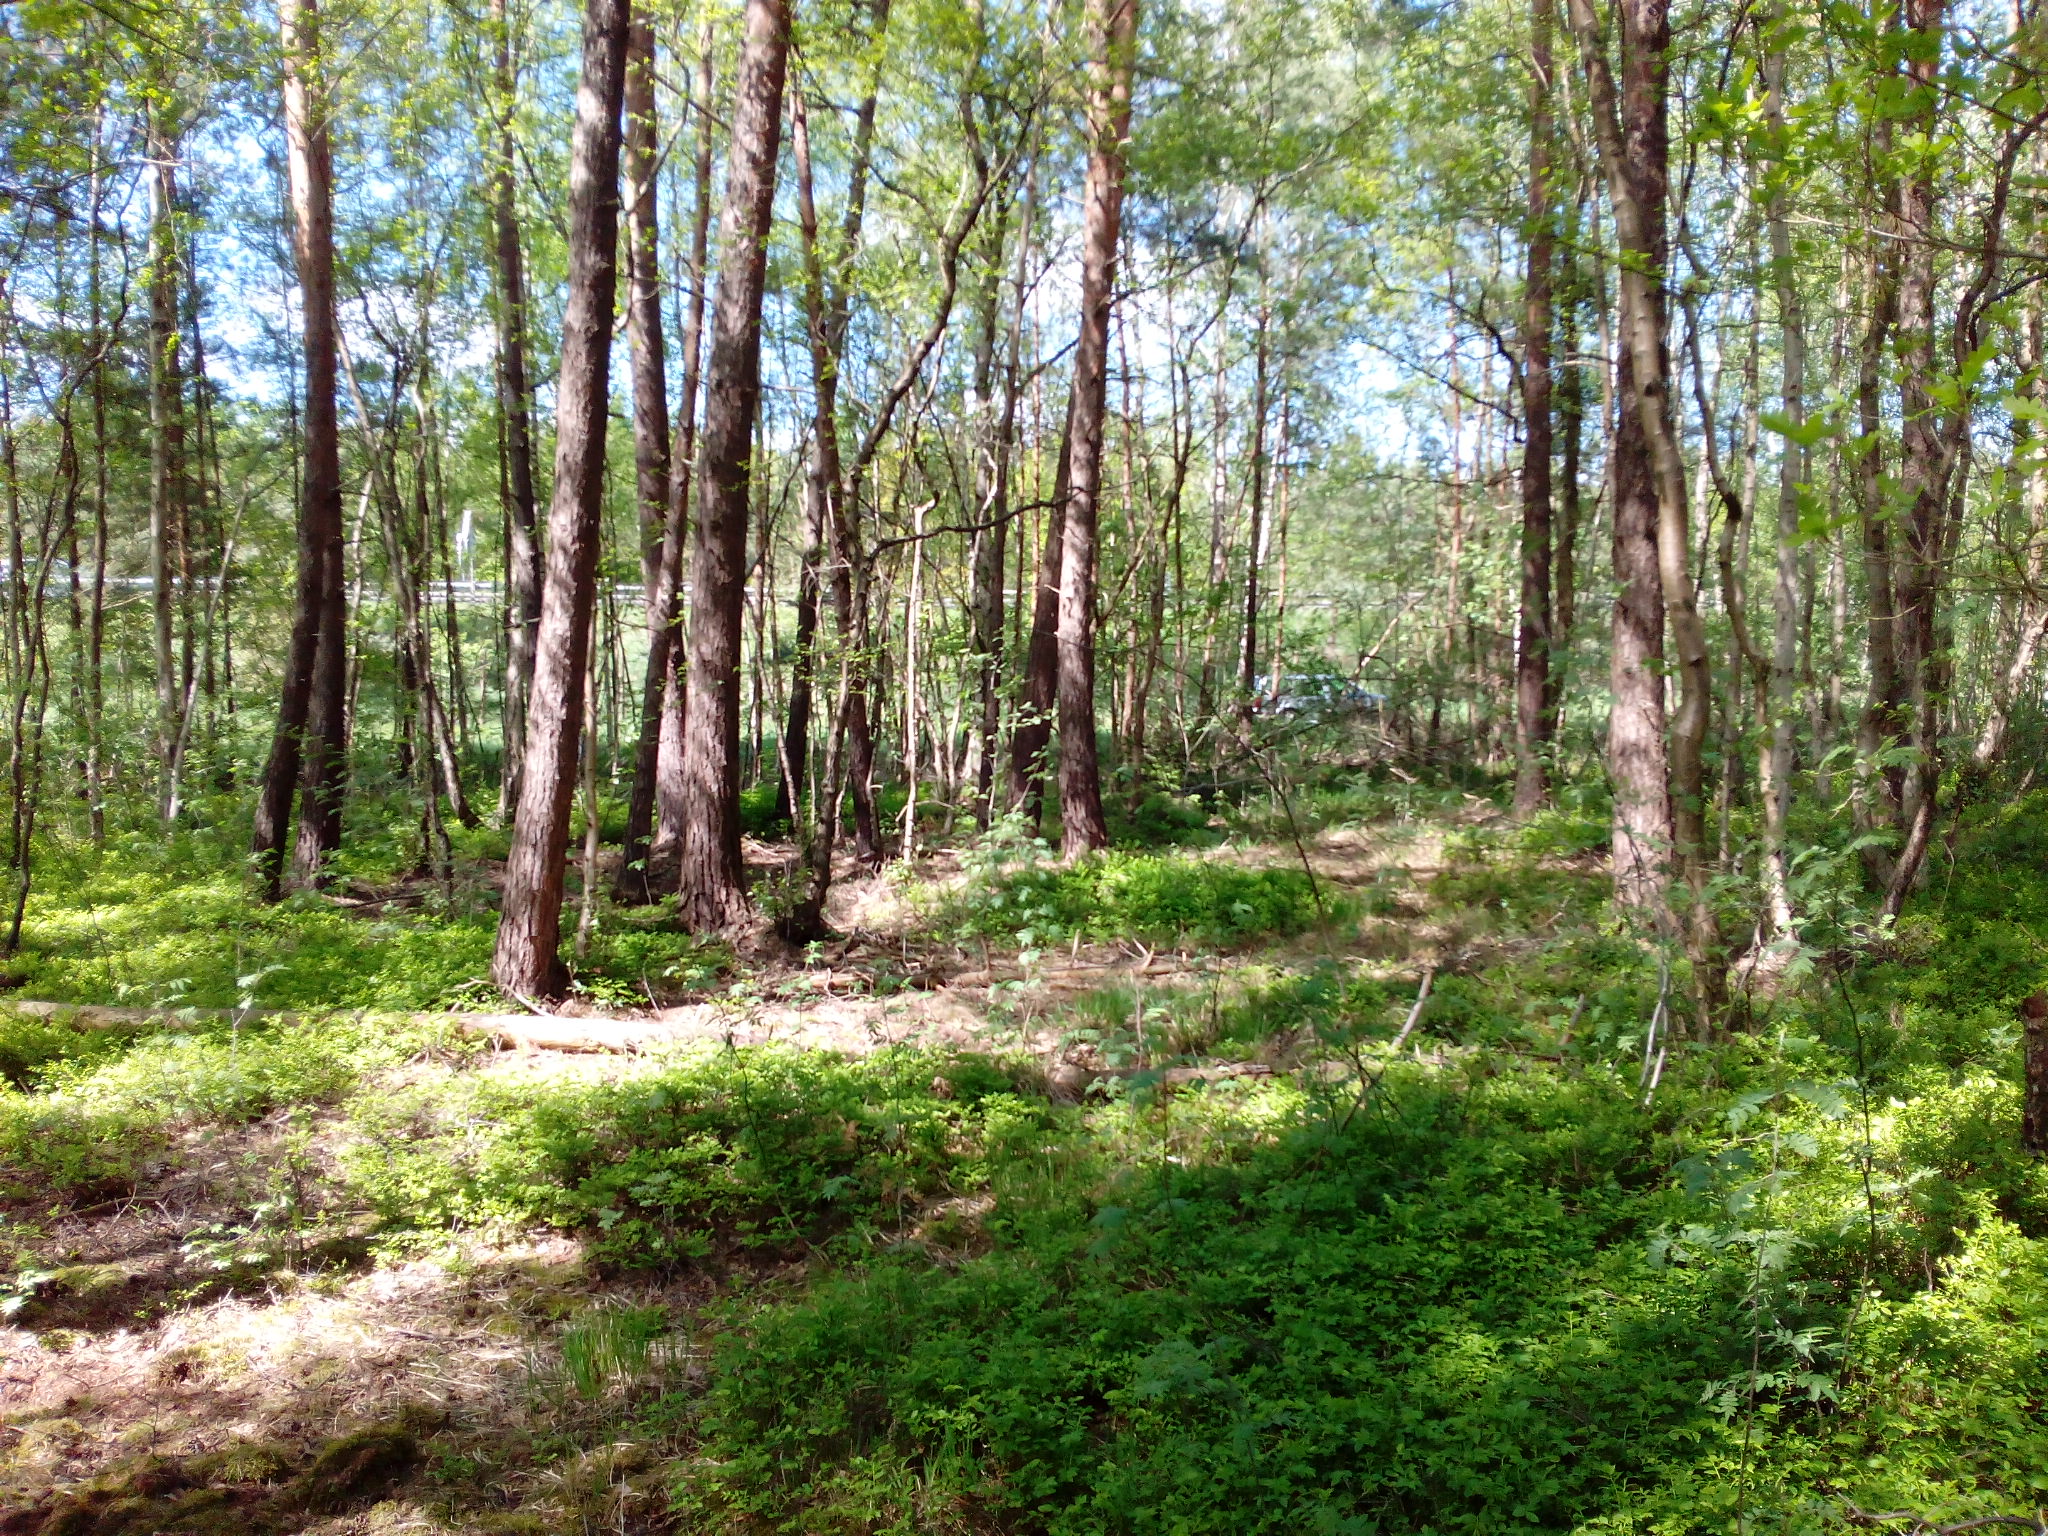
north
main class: Woodland
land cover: Pine dominated mixed woodland
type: hemiboreal forest and nemoral coniferous forest and mixed broadleaved-coniferous forest
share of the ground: > 75 %
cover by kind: coniferous forest trees 60 %, broadleaved forest trees 25 %, herbaceous plants 10 %, unconsolidated bare surface 5 %
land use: Forestry
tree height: > 5 m
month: May
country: DE
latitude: 52.4313
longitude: 9.8971
